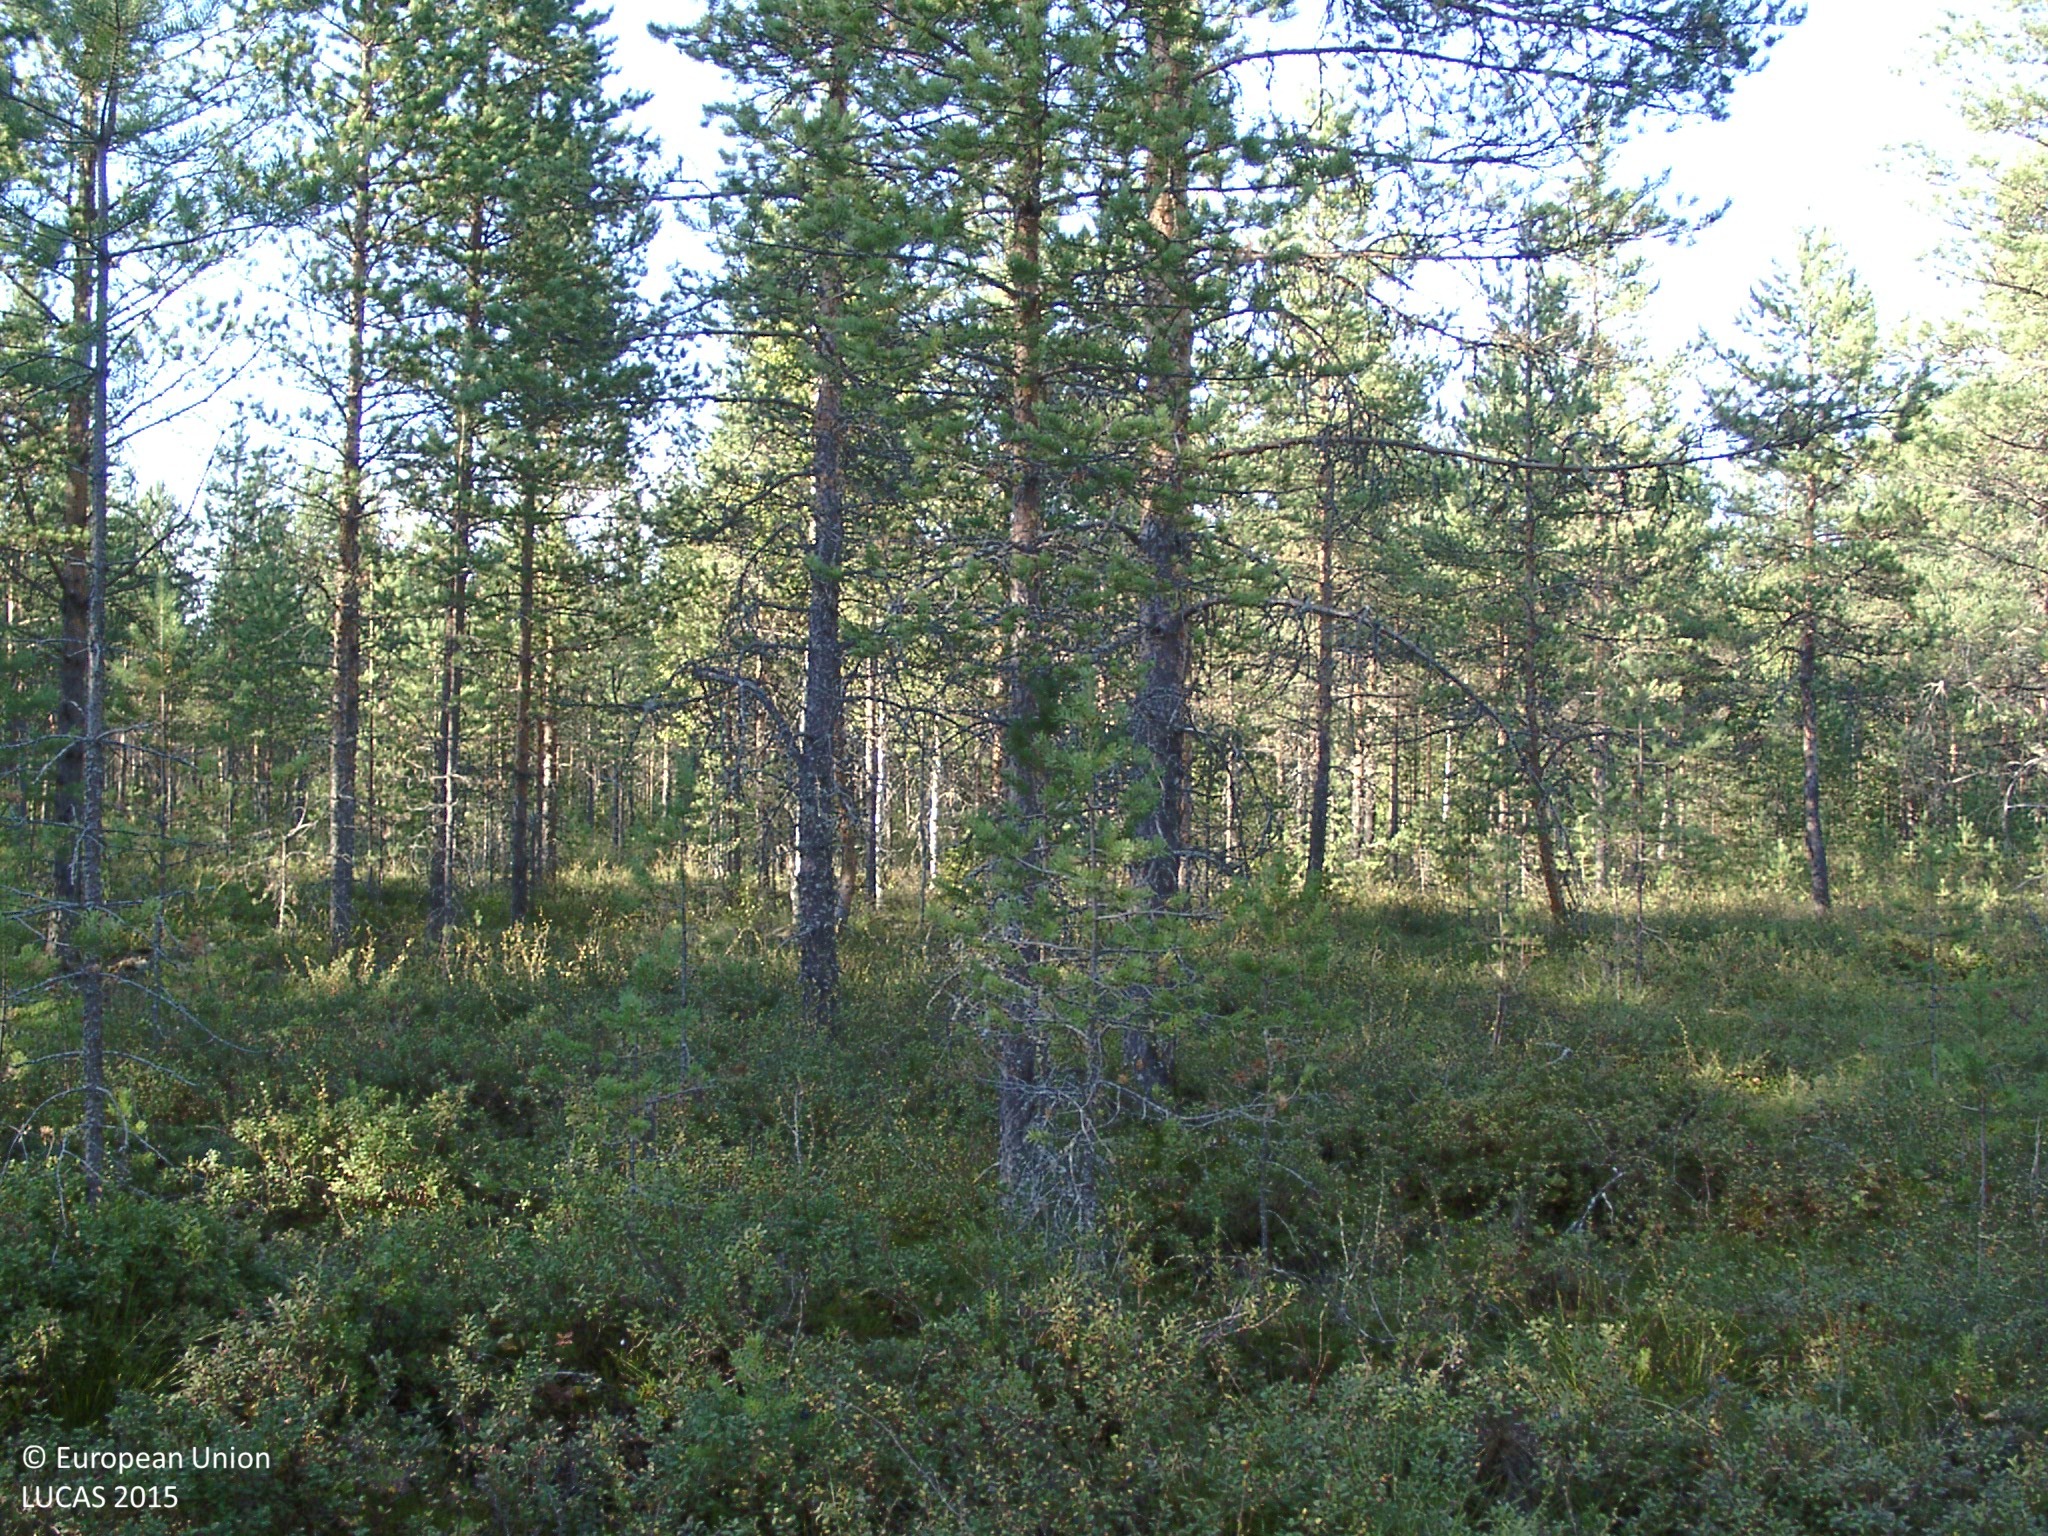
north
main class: Woodland
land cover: Pine dominated coniferous woodland
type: mire and swamp forests
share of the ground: 10 - 25 %
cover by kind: shrubs 55 %, coniferous forest trees 20 %, lichens and mosses 20 %, herbaceous plants 5 %
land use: Forestry
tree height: > 5 m
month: August
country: FI
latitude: 61.8736
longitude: 24.9948
